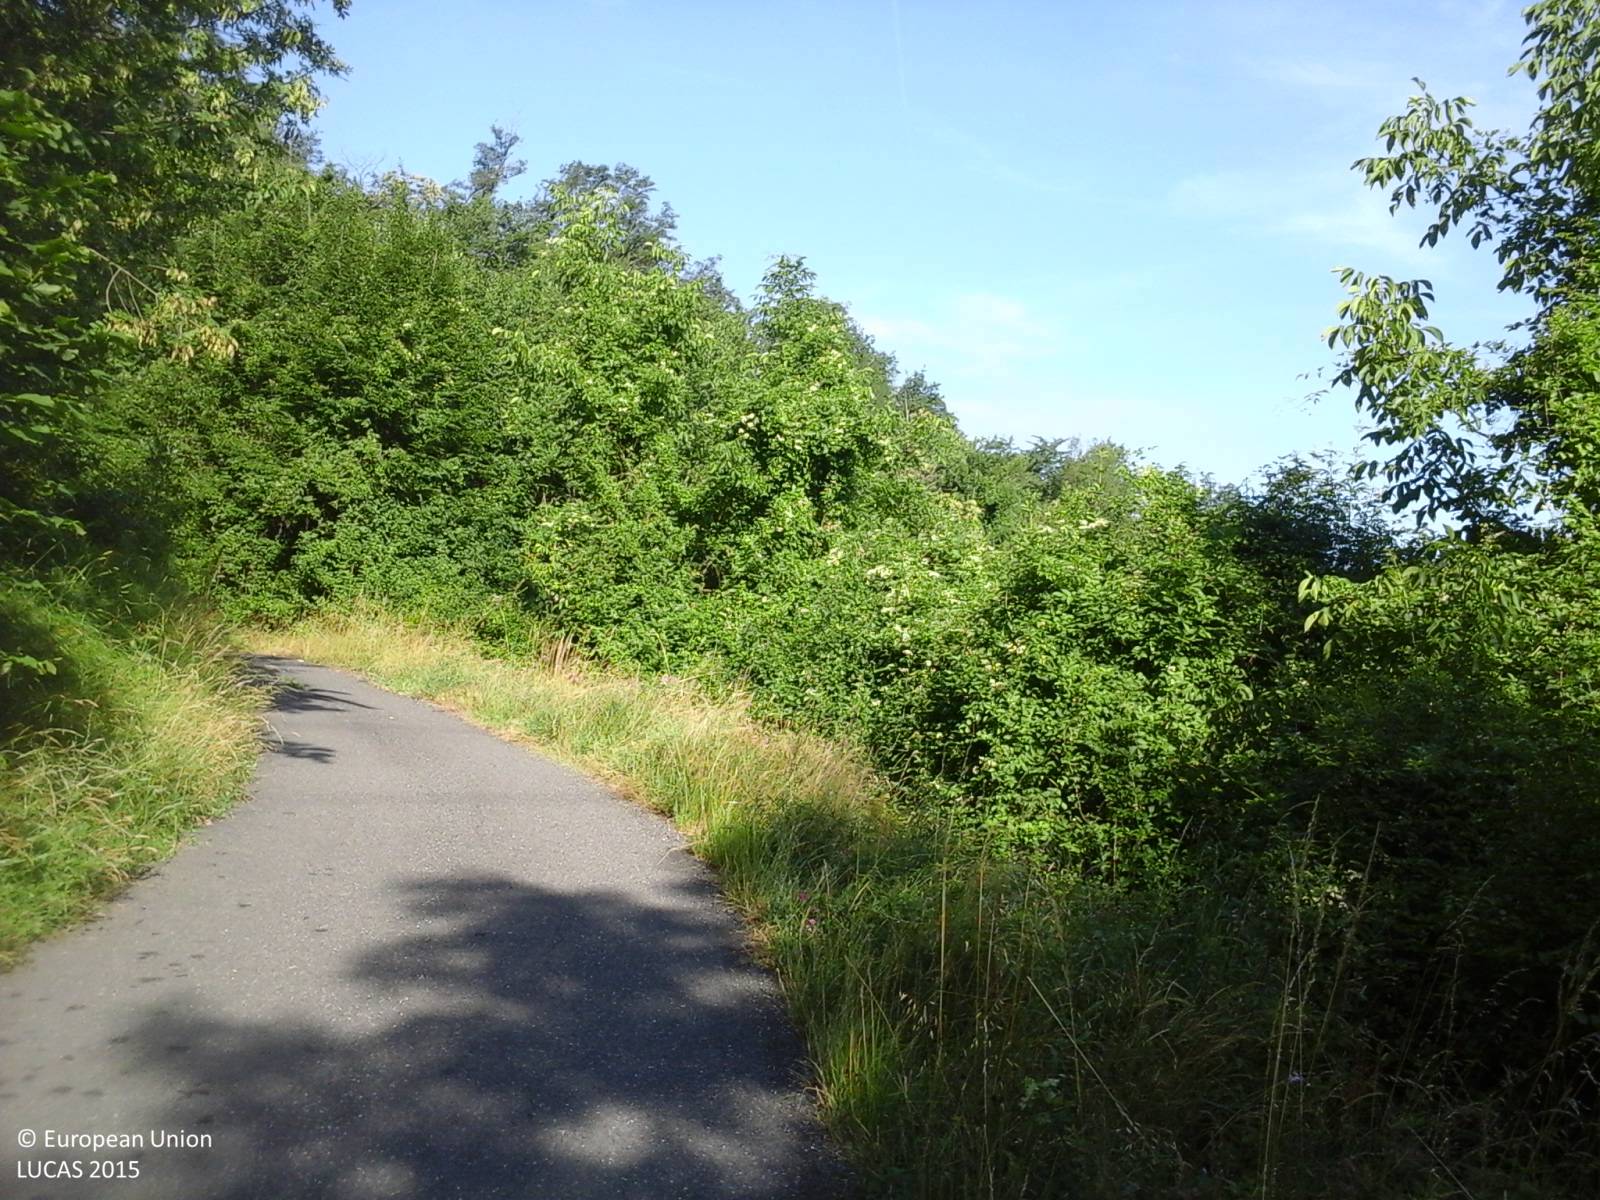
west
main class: Woodland
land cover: Broadleaved woodland
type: thermophilous deciduous forest
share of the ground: > 75 %
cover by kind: broadleaved forest trees 50 %, shrubs 50 %
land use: Forestry
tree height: > 5 m
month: June
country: IT
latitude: 44.3505
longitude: 9.8874
